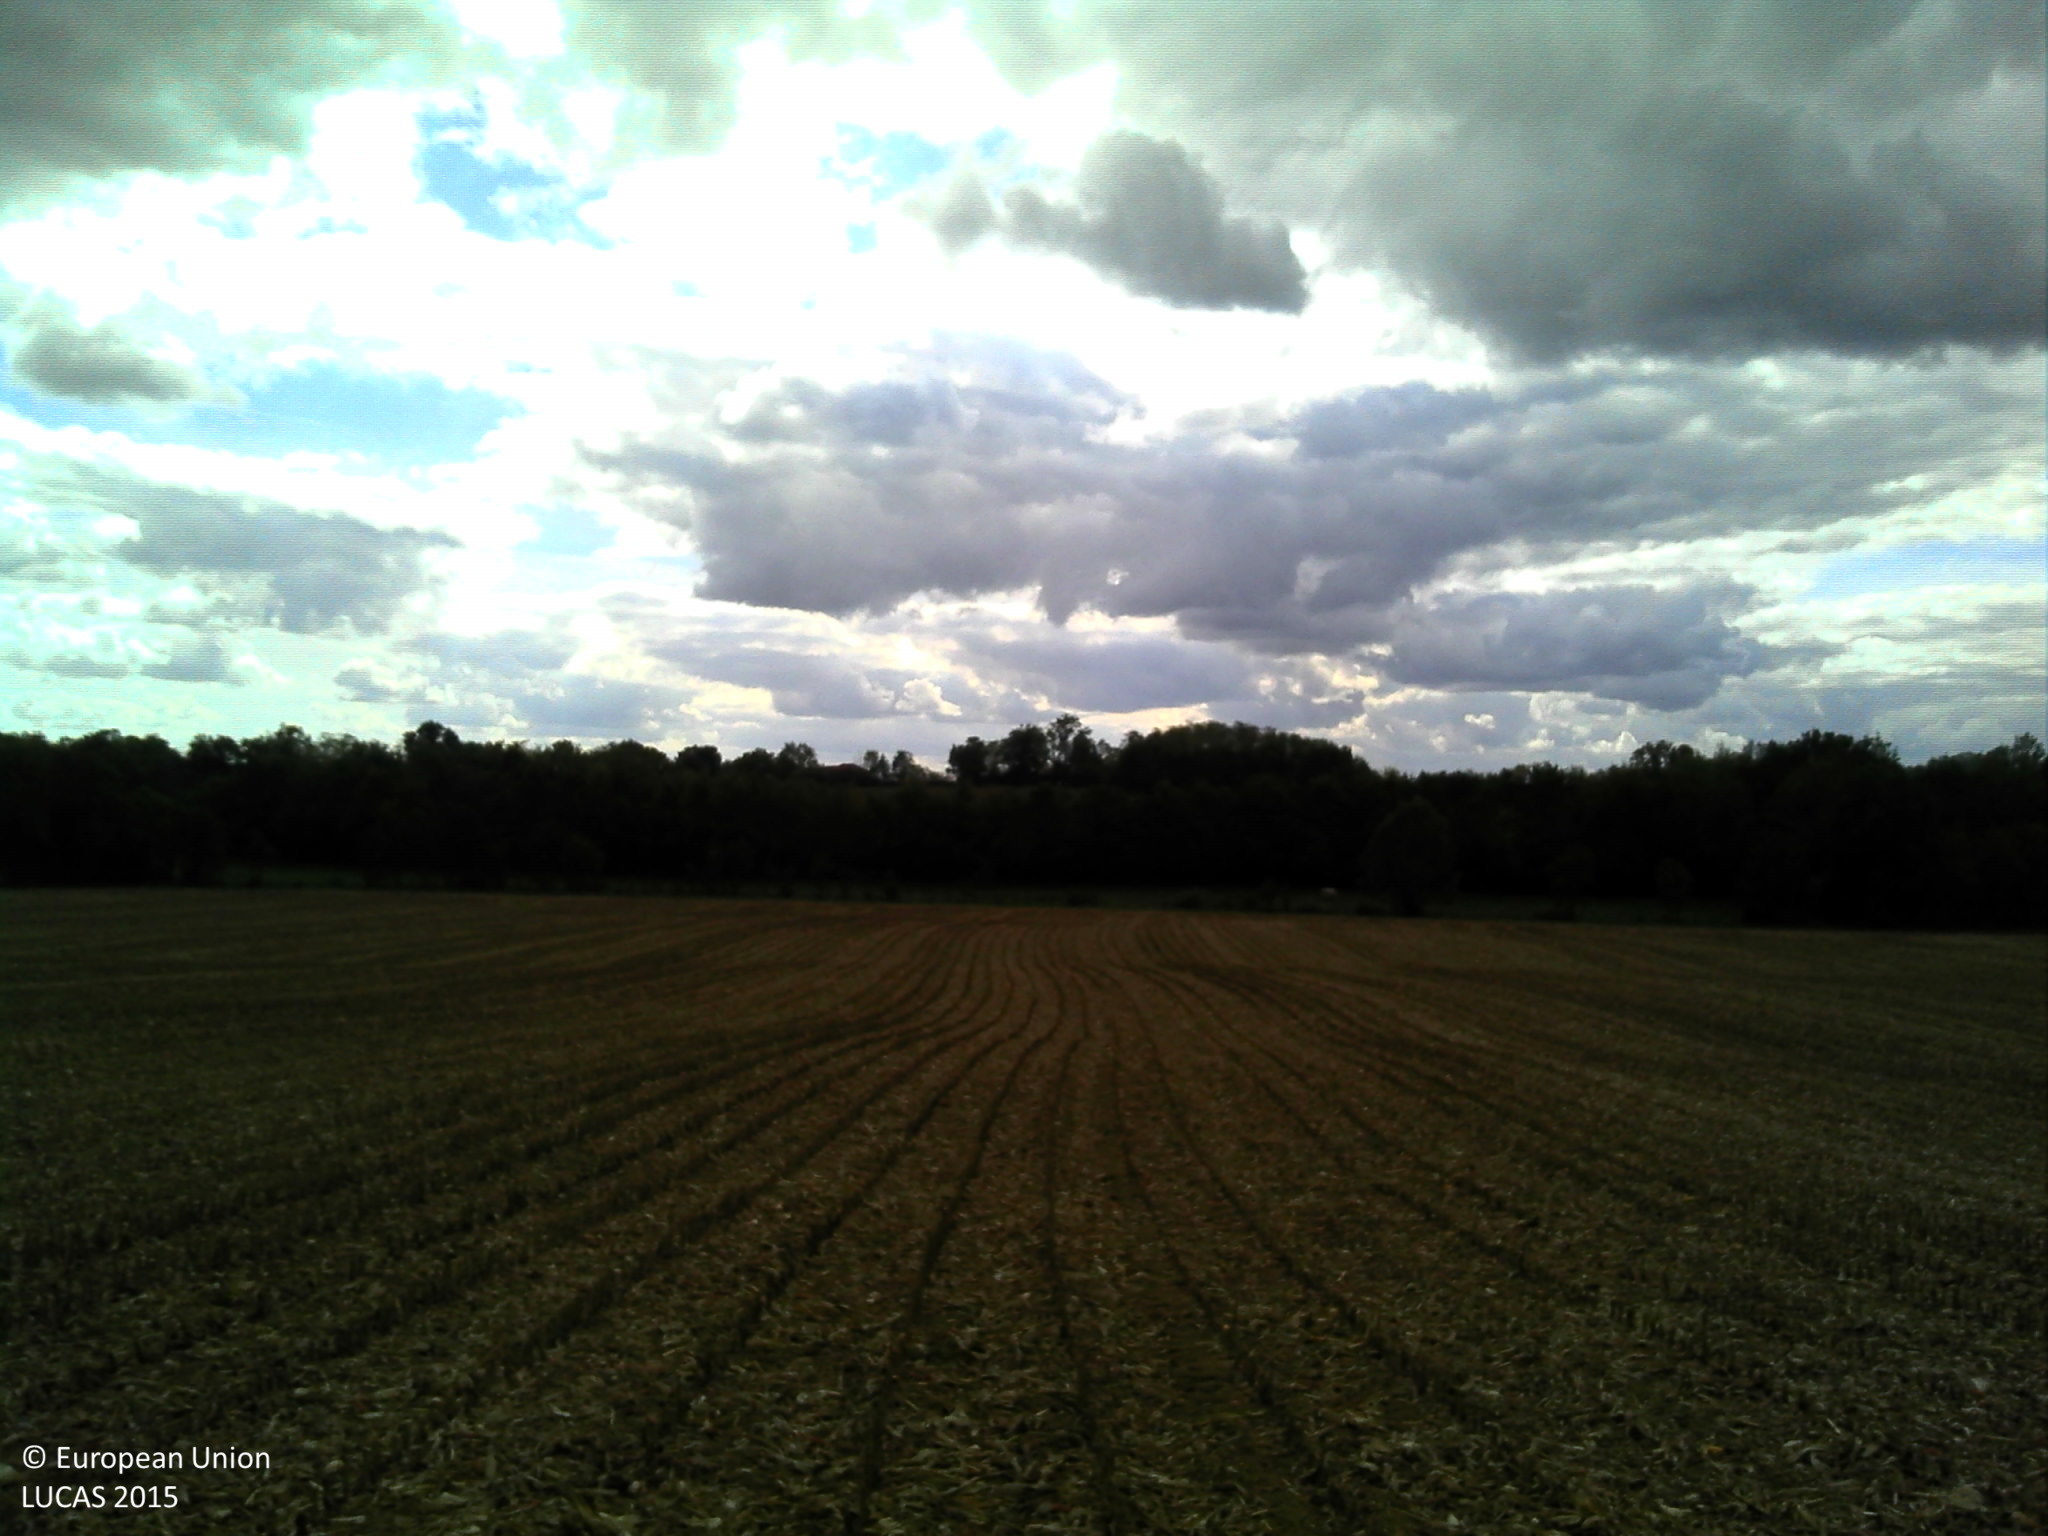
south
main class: Cropland
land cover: Maize
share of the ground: < 10 %
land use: Agriculture (excluding fallow land and kitchen gardens)
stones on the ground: < 10 %
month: October
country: FR
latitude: 46.3606
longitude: 4.9985
